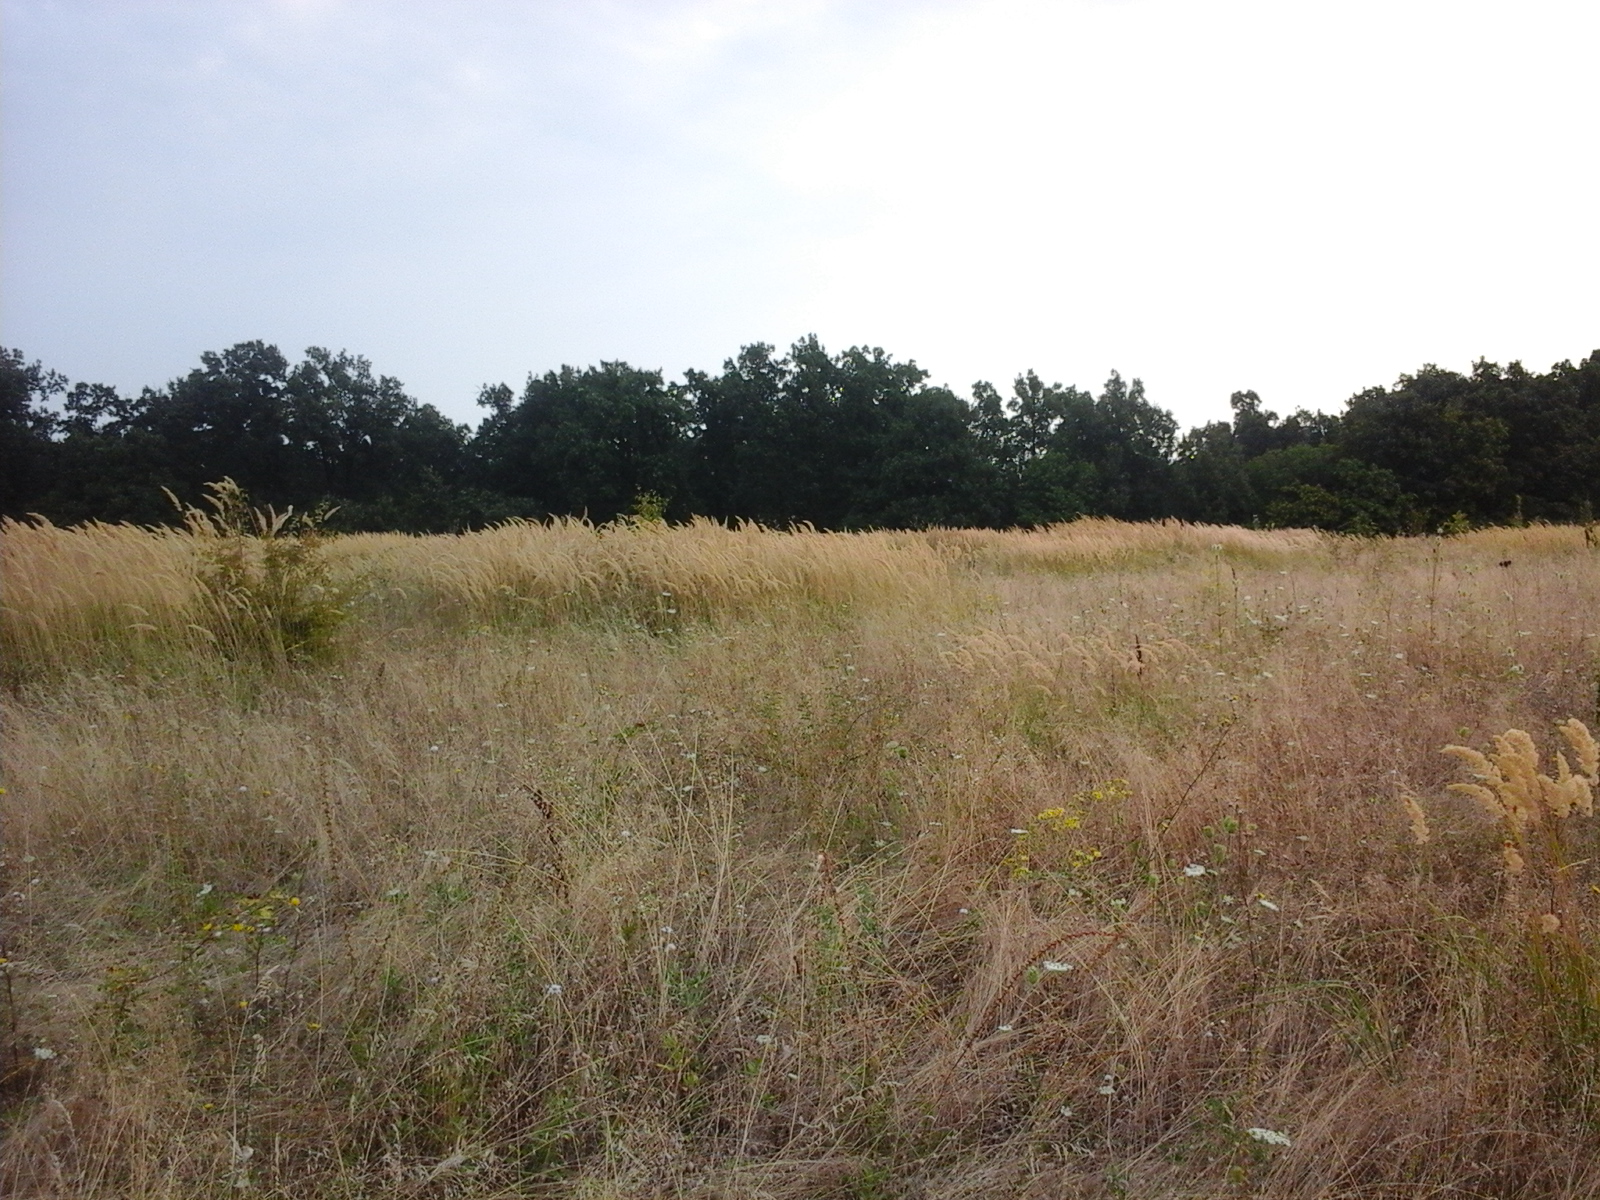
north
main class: Grassland
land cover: Spontaneously vegetated surfaces
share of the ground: > 75 %
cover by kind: herbaceous plants 100 %
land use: Fallow land
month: August
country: RO
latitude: 44.4766
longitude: 23.8504
